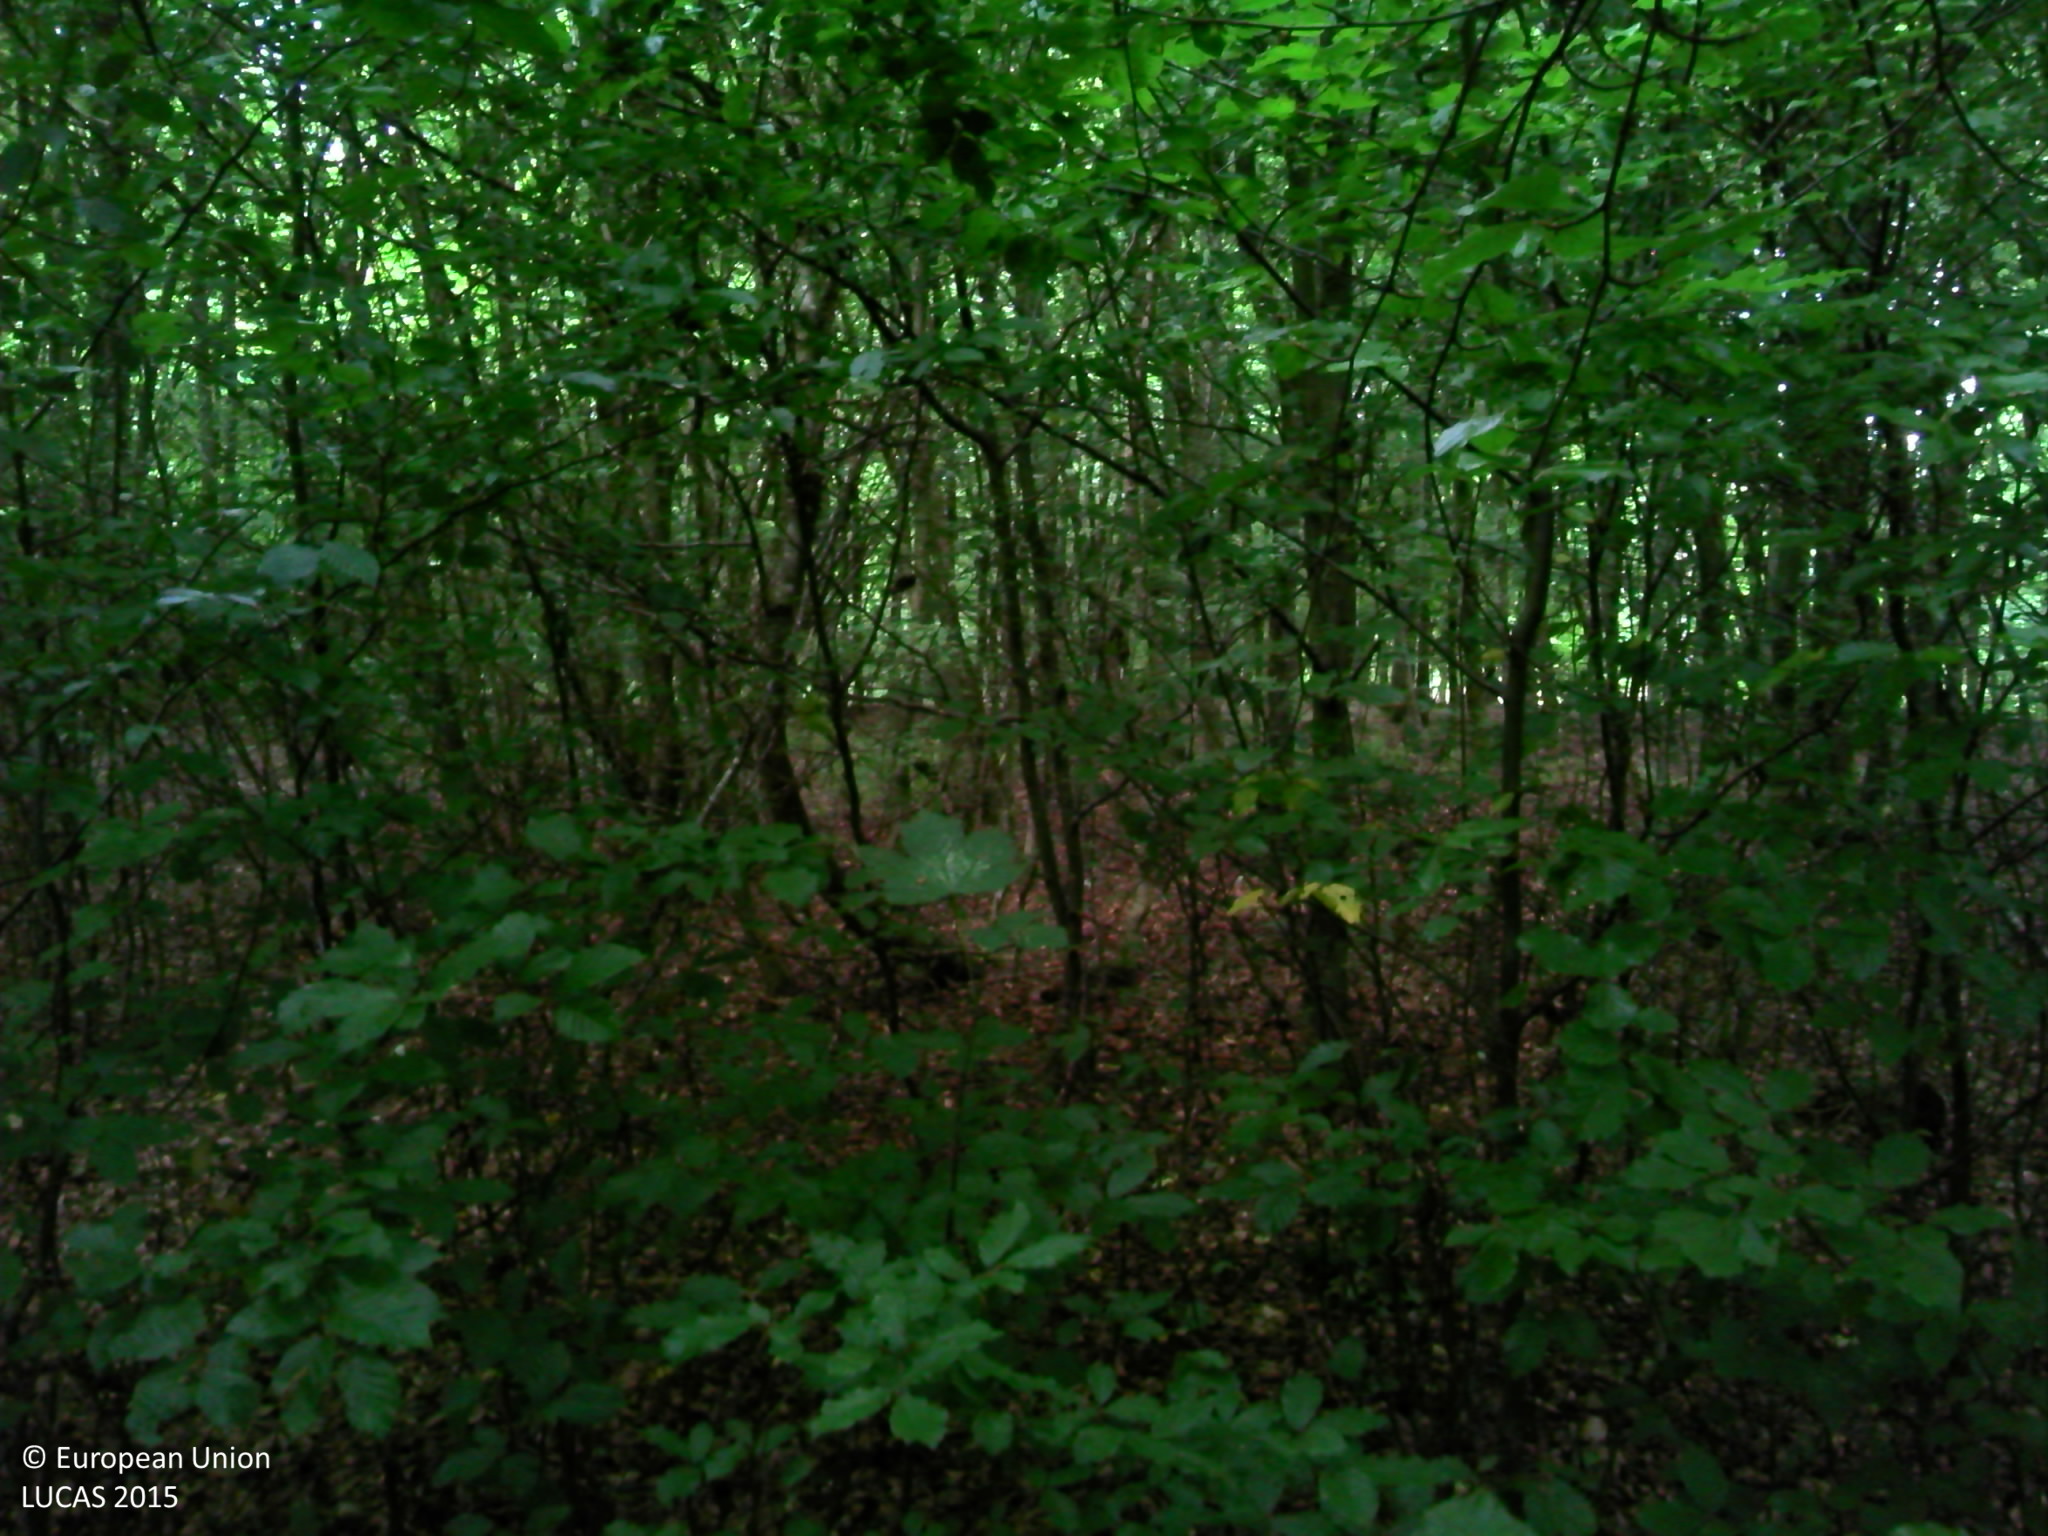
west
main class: Woodland
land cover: Broadleaved woodland
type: beech forest
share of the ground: > 75 %
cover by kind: broadleaved forest trees 100 %
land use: Forestry
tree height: > 5 m
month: July
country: BE
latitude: 49.6315
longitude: 5.6097
